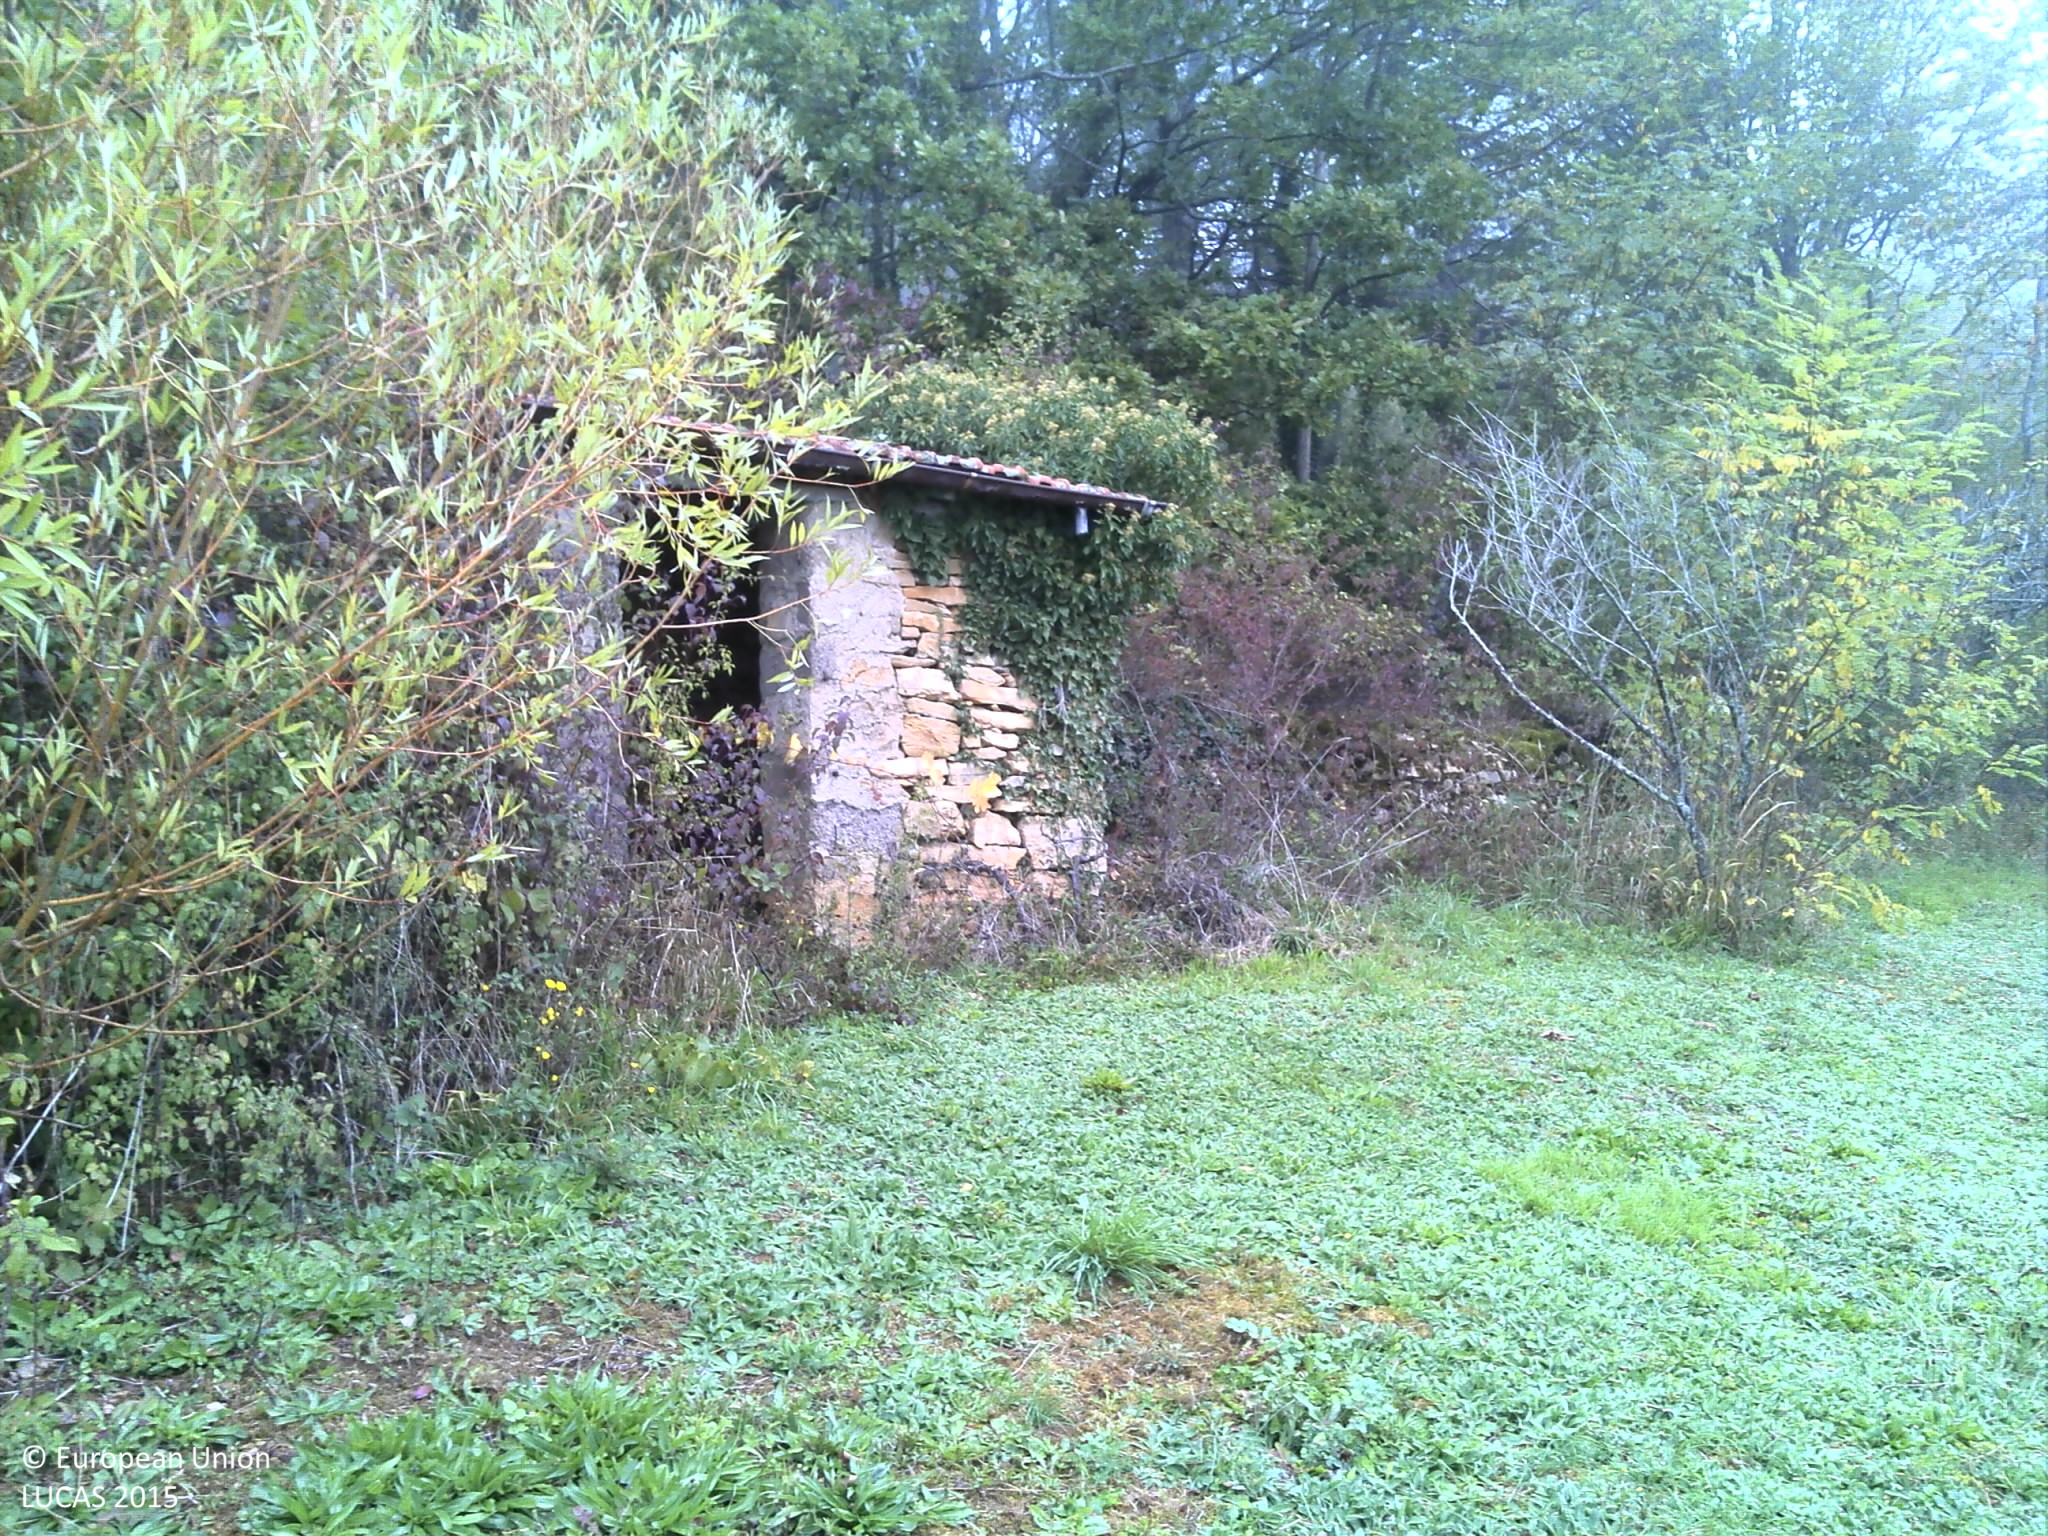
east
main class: Cropland
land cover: Apple fruit
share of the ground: 10 - 25 %
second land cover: Grassland without tree/shrub cover
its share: > 75 %
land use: Kitchen garden
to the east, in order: Apple fruit; Grassland without tree/shrub cover; Dry stone walls; Broadleaved woodland; Grassland without tree/shrub cover; Broadleaved woodland; Grassland without tree/shrub cover; Fences; Grass margins; Paved roads, cycling and walking lanes; Grass margins; Abandoned hedges; Fences; Grassland without tree/shrub cover
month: October
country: FR
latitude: 46.3769
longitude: 5.3614
